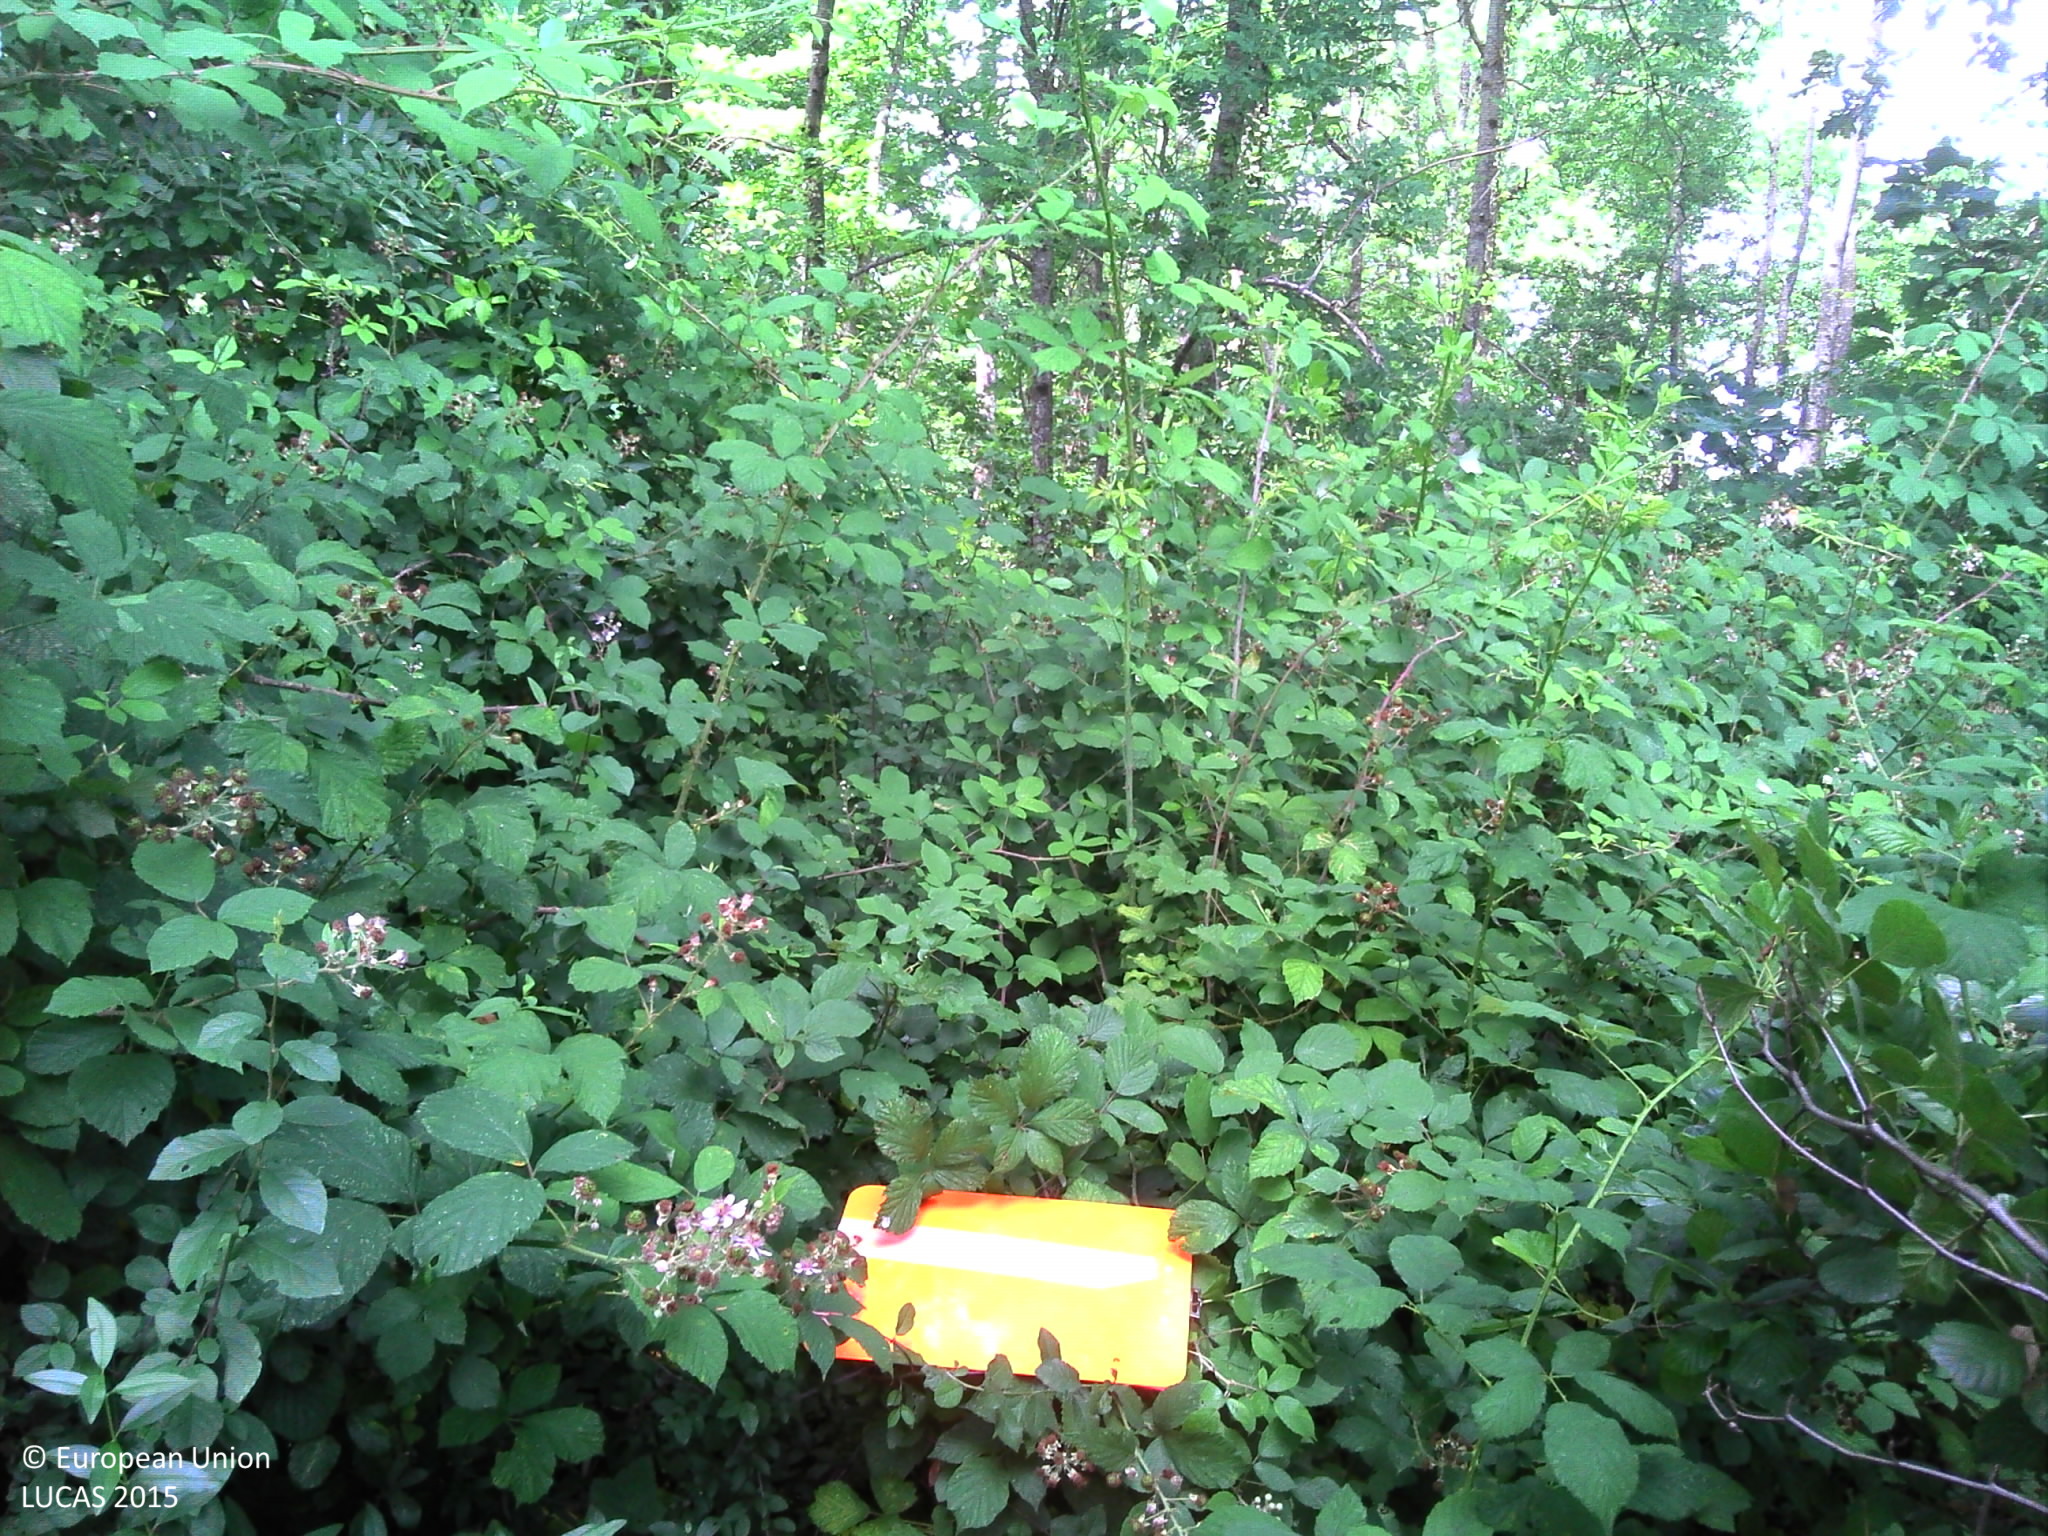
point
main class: Woodland
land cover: Broadleaved woodland
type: acidophilous oak and oak-birch forest
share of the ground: > 75 %
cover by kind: broadleaved forest trees 70 %, shrubs 20 %, herbaceous plants 10 %
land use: Forestry
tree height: > 5 m
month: June
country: FR
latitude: 46.4477
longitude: 5.3292
